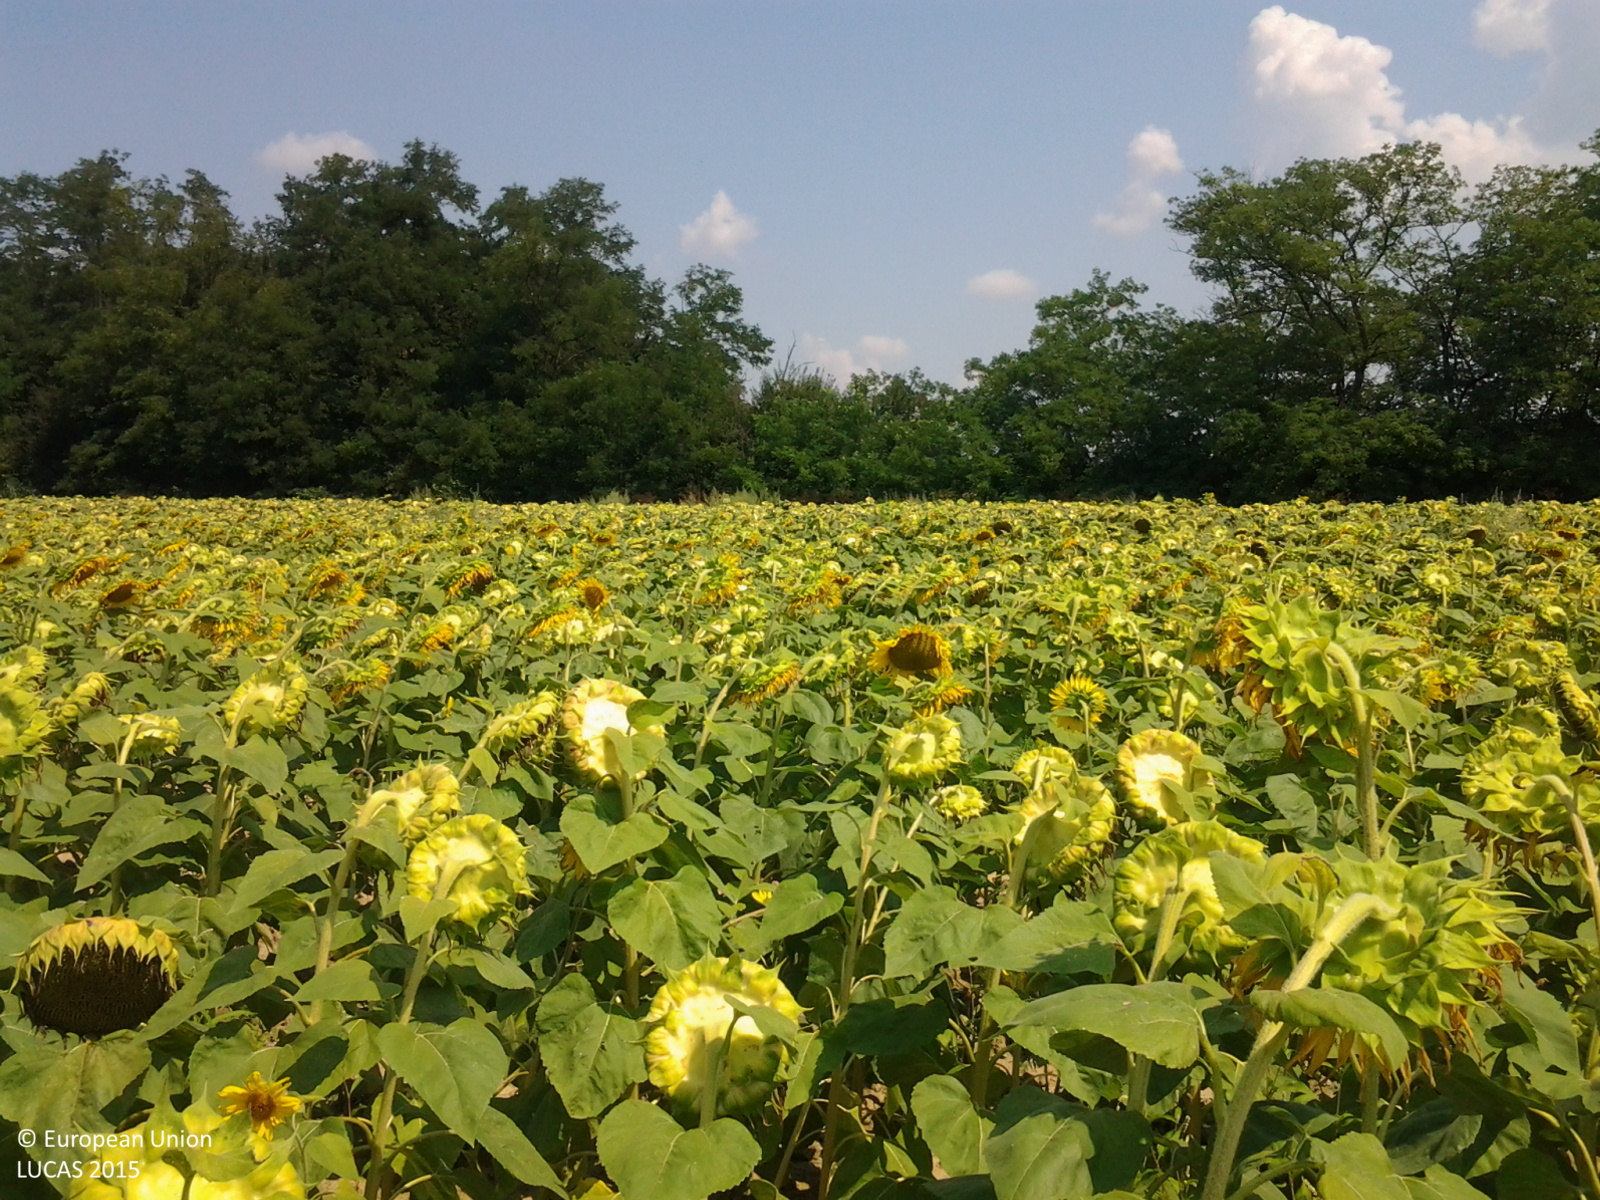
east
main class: Cropland
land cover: Sunflower
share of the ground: > 75 %
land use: Agriculture (excluding fallow land and kitchen gardens)
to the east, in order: Sunflower; Shrubland with sparse tree cover; Ditches and canals; Rice; Broadleaved woodland; Common wheat
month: August
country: HU
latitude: 46.3677
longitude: 17.3743
